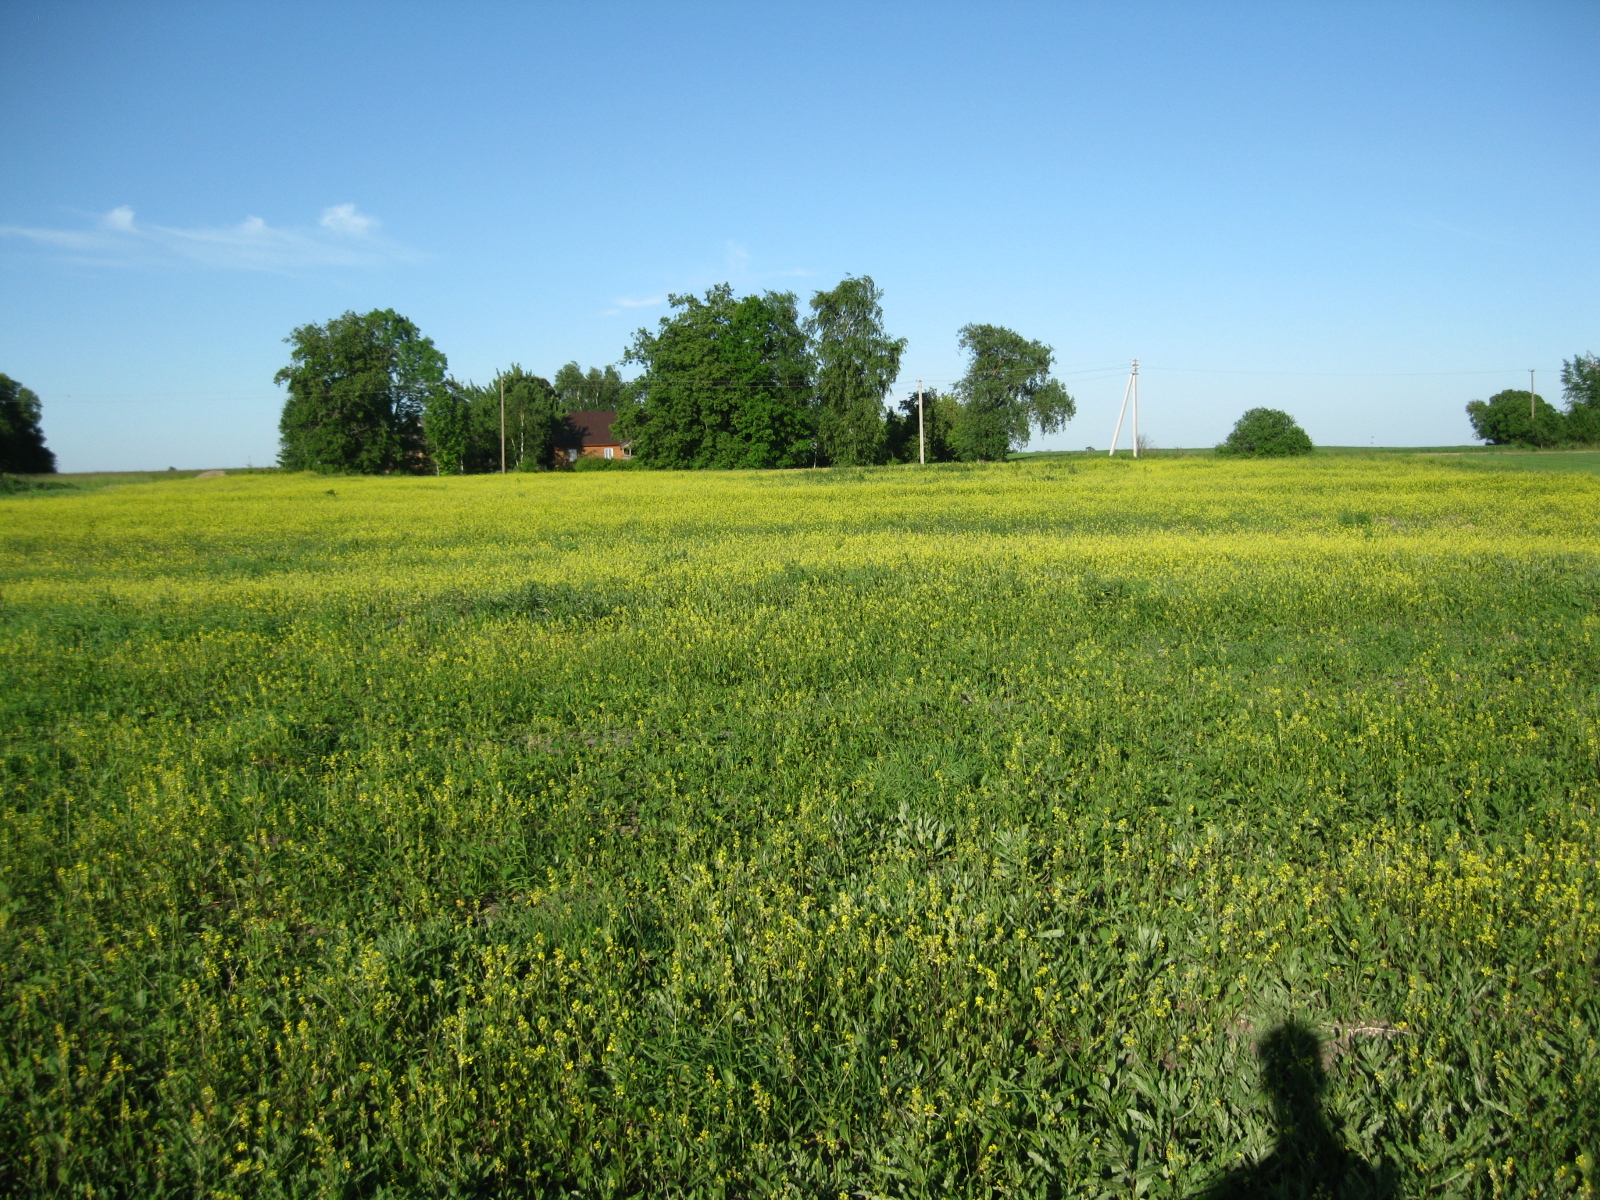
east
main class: Cropland
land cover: Rape and turnip rape
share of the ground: > 75 %
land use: Agriculture (excluding fallow land and kitchen gardens)
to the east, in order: Rape and turnip rape; Spontaneously vegetated surfaces; Electric lines; Spontaneously vegetated surfaces; Tracks; Broadleaved woodland; Apple fruit; Other root crops; Other fresh vegetables; Grassland without tree/shrub cover; Barley
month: June
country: LT
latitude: 55.8043
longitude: 23.9511
